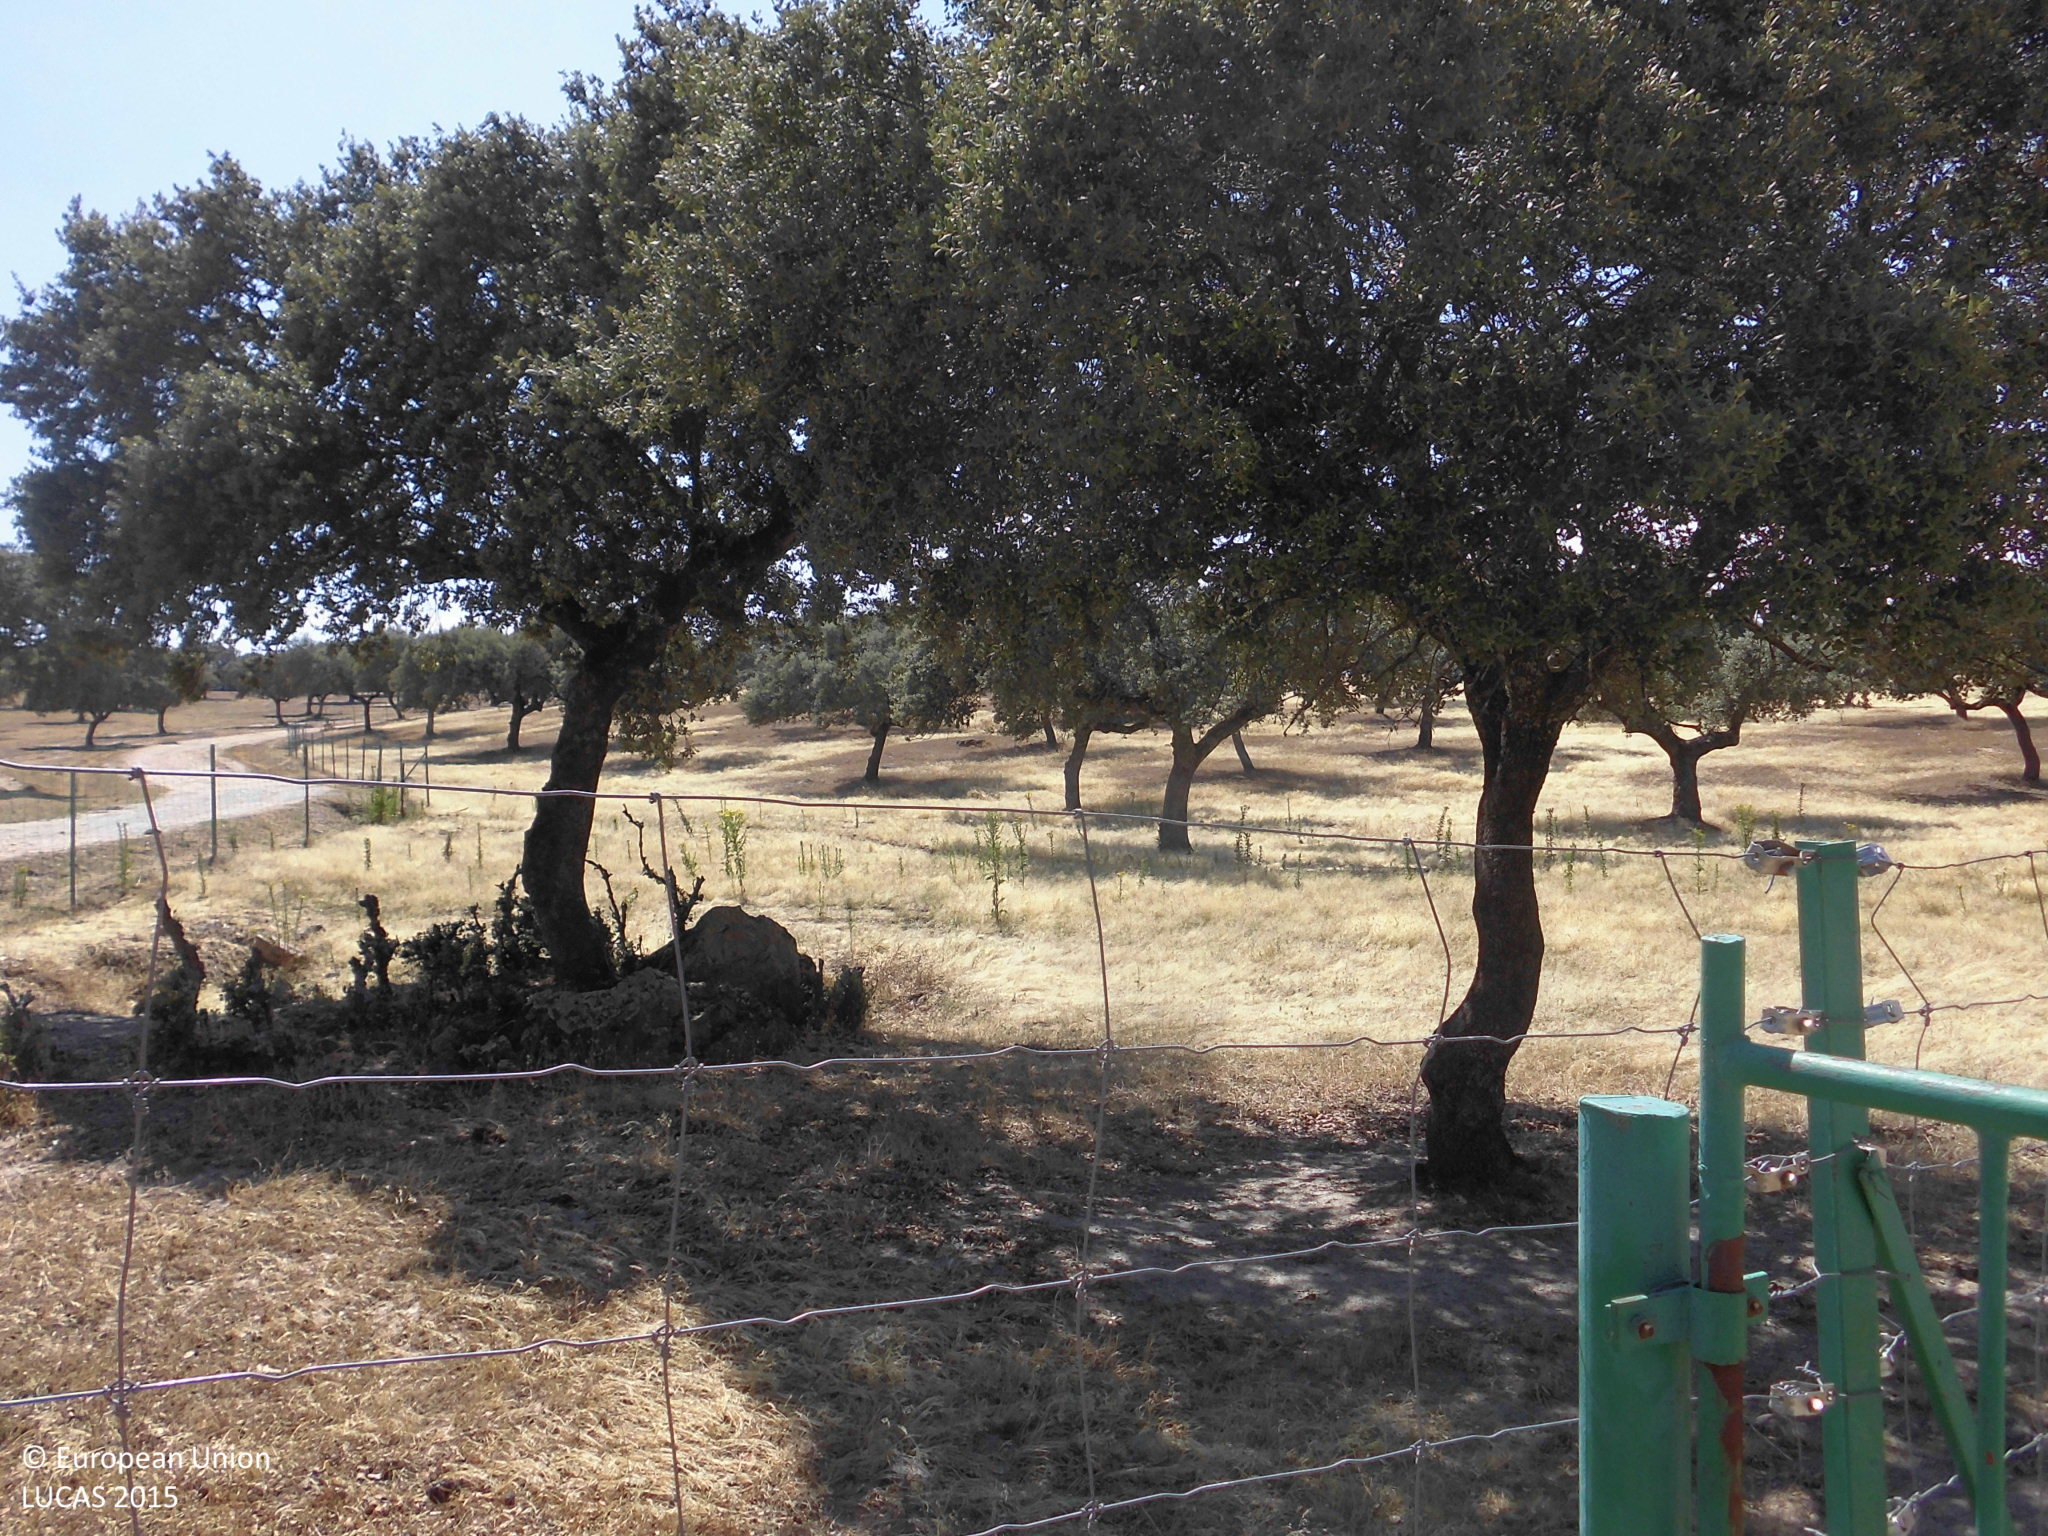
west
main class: Woodland
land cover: Broadleaved woodland
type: broadleaved evergreen forest
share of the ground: 25 - 50 %
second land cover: Grassland without tree/shrub cover
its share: > 75 %
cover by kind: herbaceous plants 65 %, broadleaved forest trees 35 %
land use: Forestry
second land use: Agriculture (excluding fallow land and kitchen gardens)
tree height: > 5 m
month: June
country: ES
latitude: 39.7849
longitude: -6.1475
